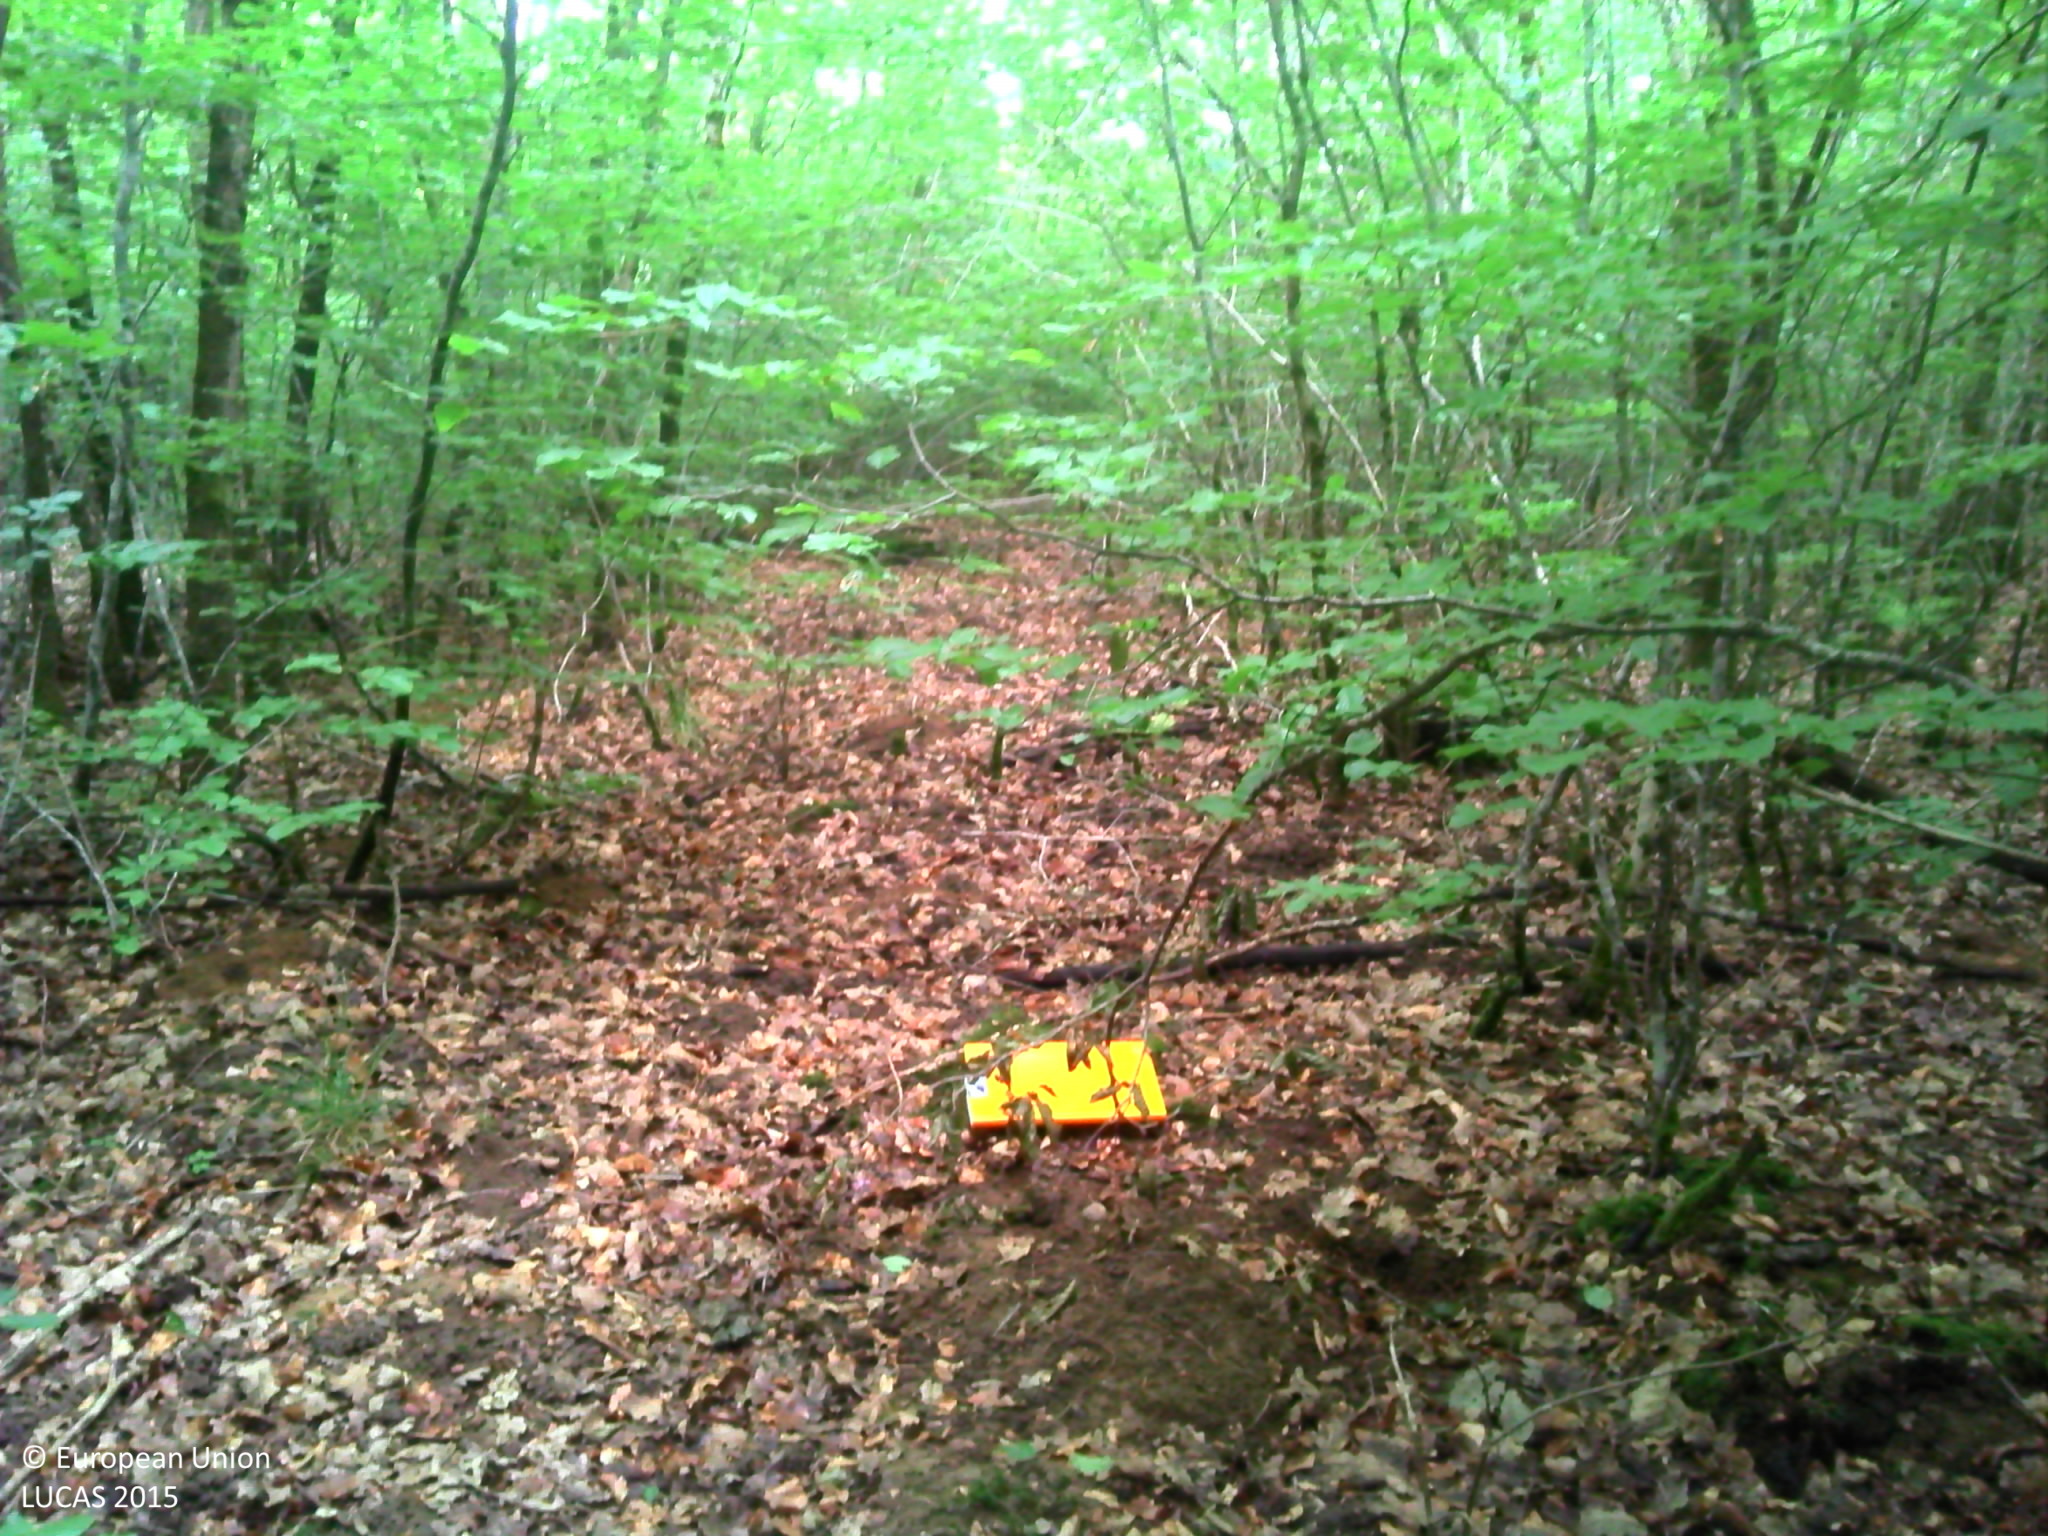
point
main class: Woodland
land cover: Broadleaved woodland
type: beech forest
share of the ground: > 75 %
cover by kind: broadleaved forest trees 90 %, unconsolidated bare surface 10 %
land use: Forestry
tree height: > 5 m
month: June
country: FR
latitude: 47.9109
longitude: 6.3483
